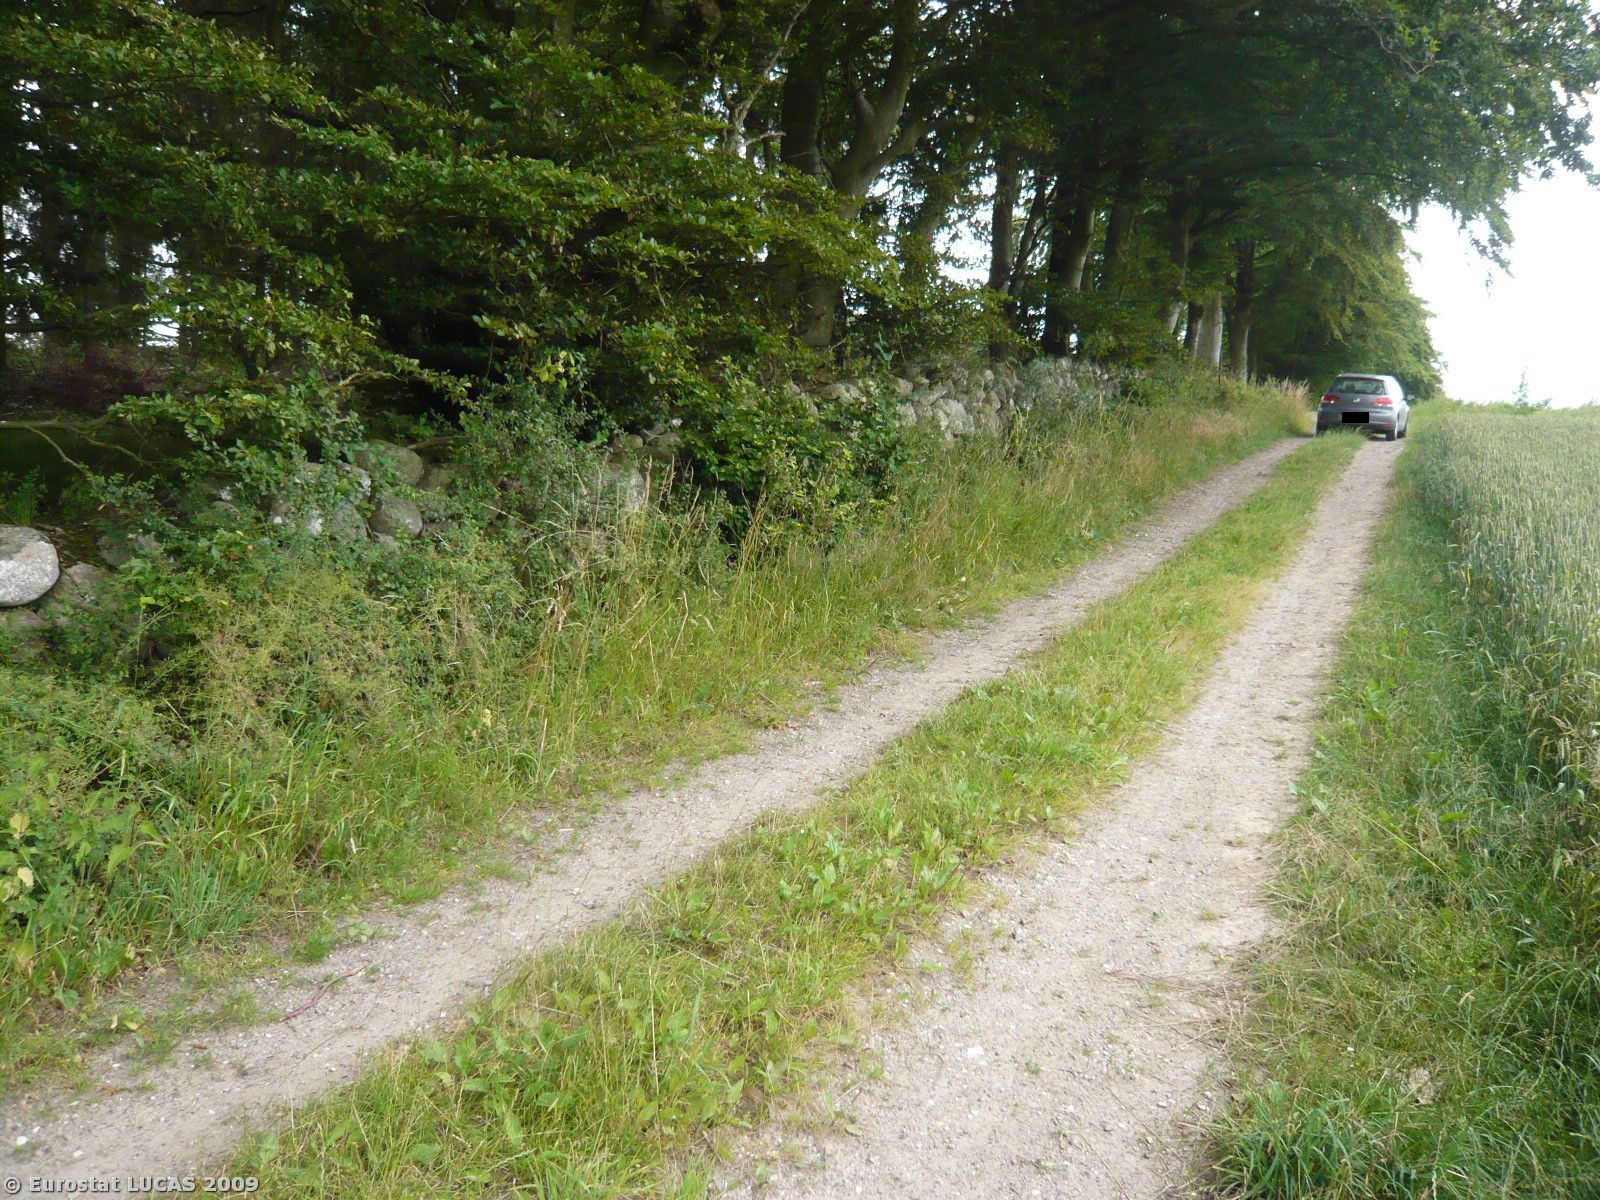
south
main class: Cropland
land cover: Common wheat
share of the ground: > 75 %
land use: Agriculture (excluding fallow land and kitchen gardens)
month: July
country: DK
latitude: 55.5293
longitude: 11.6937
